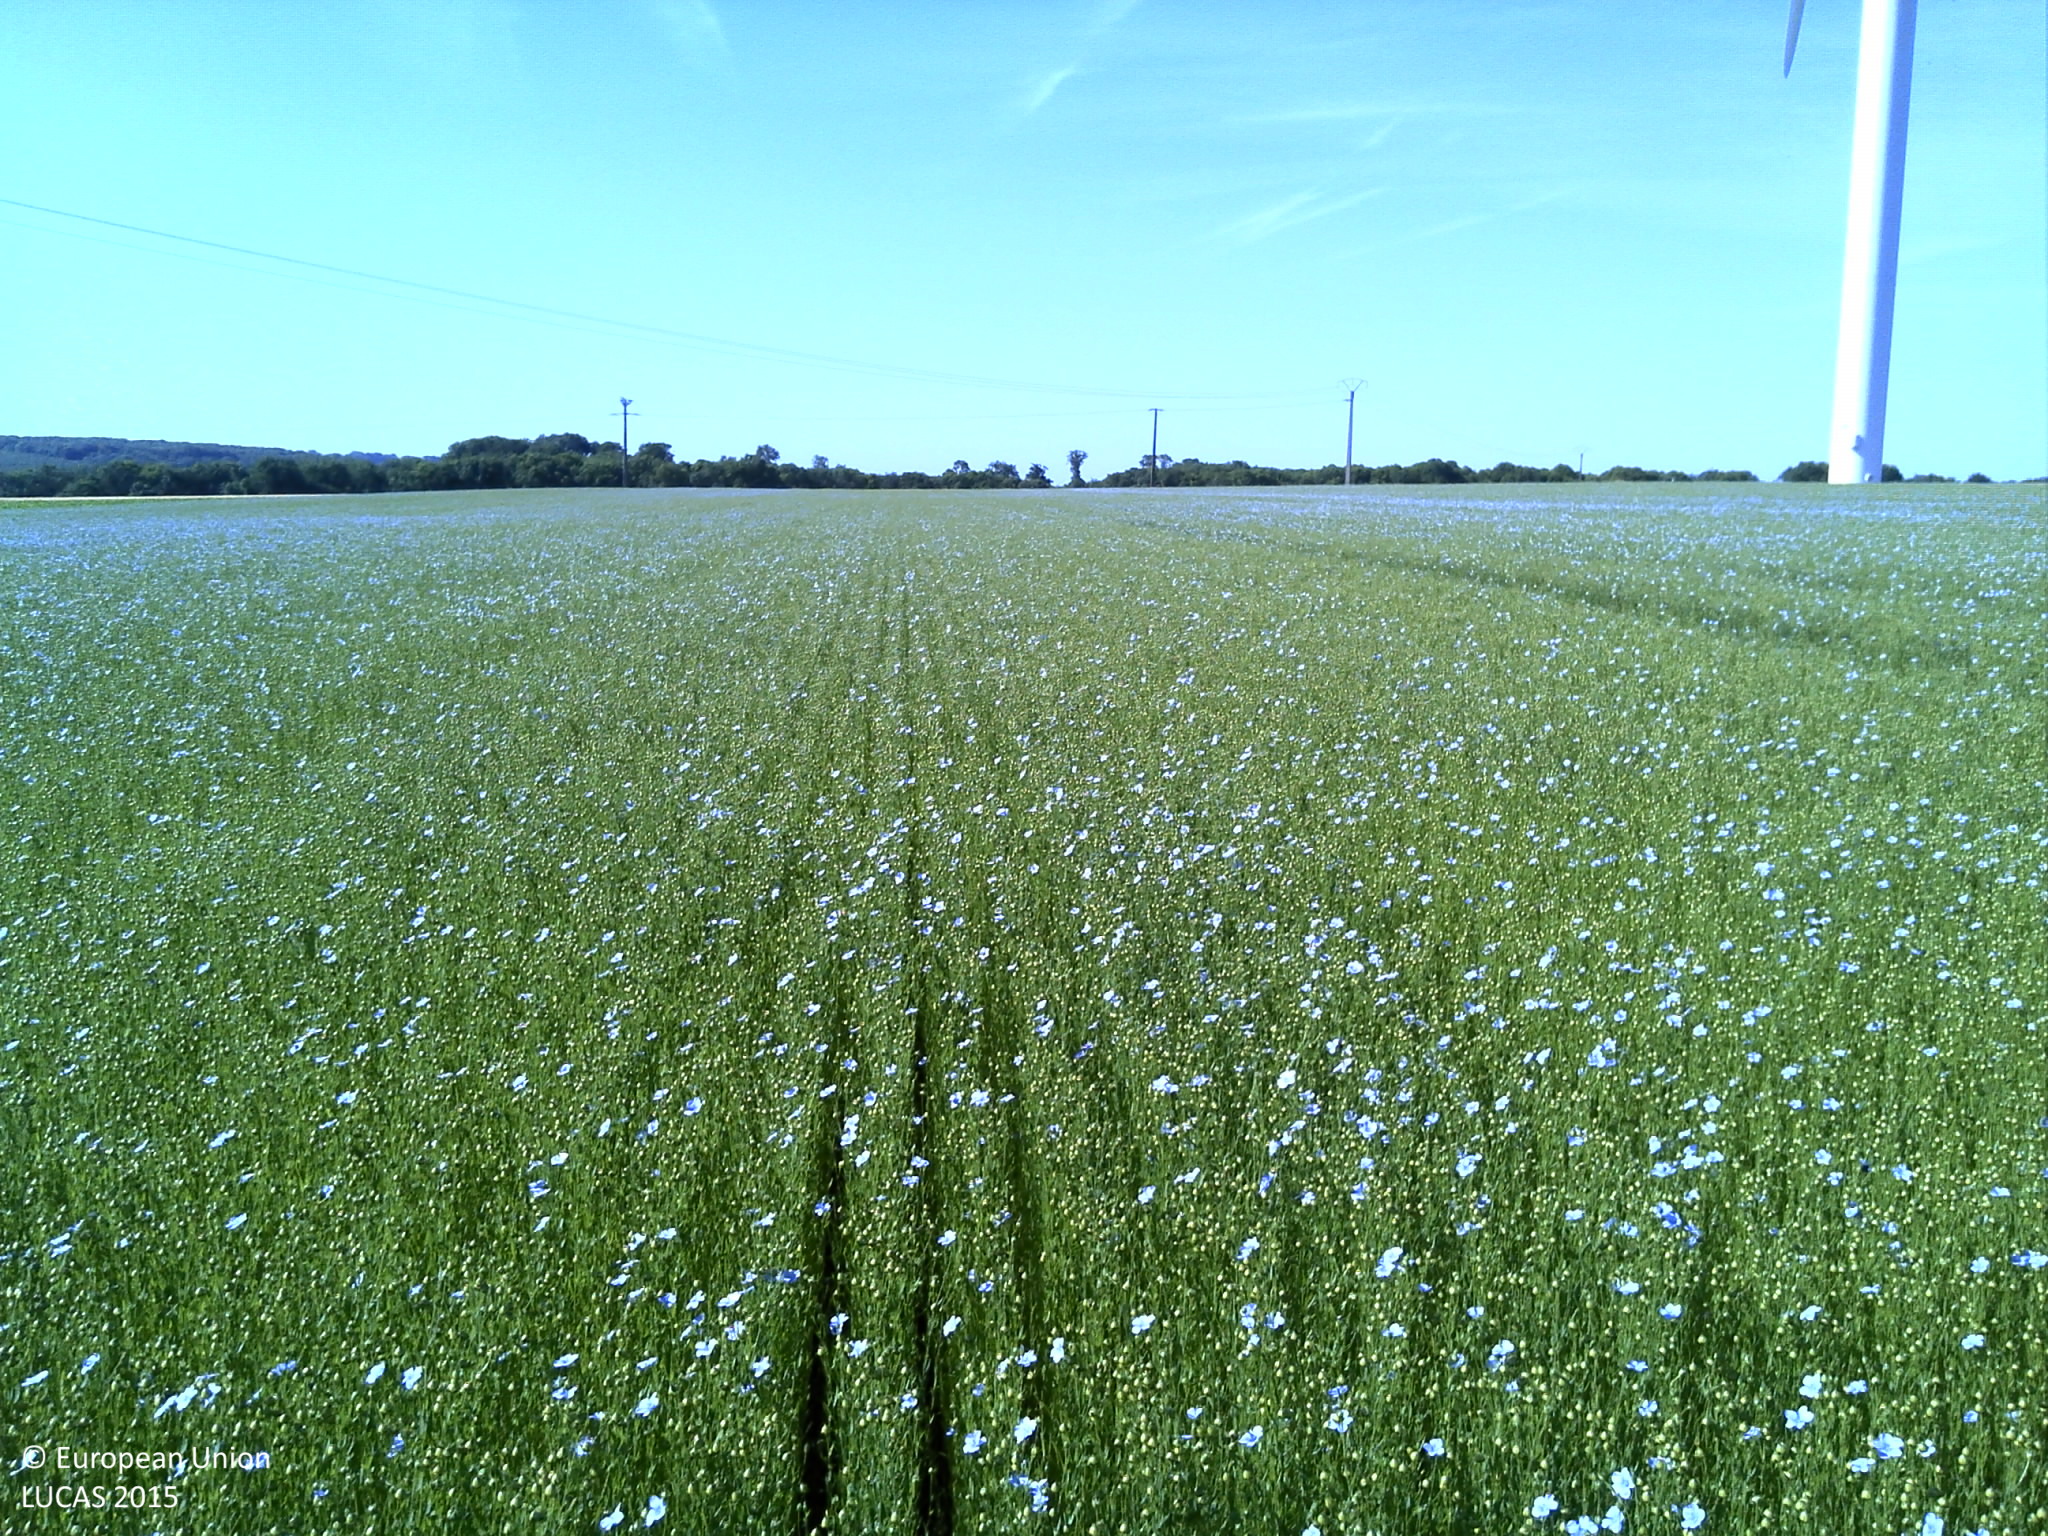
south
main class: Cropland
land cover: Other fibre and oleaginous crops
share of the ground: > 75 %
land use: Agriculture (excluding fallow land and kitchen gardens)
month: June
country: FR
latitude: 49.8041
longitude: 0.9314
